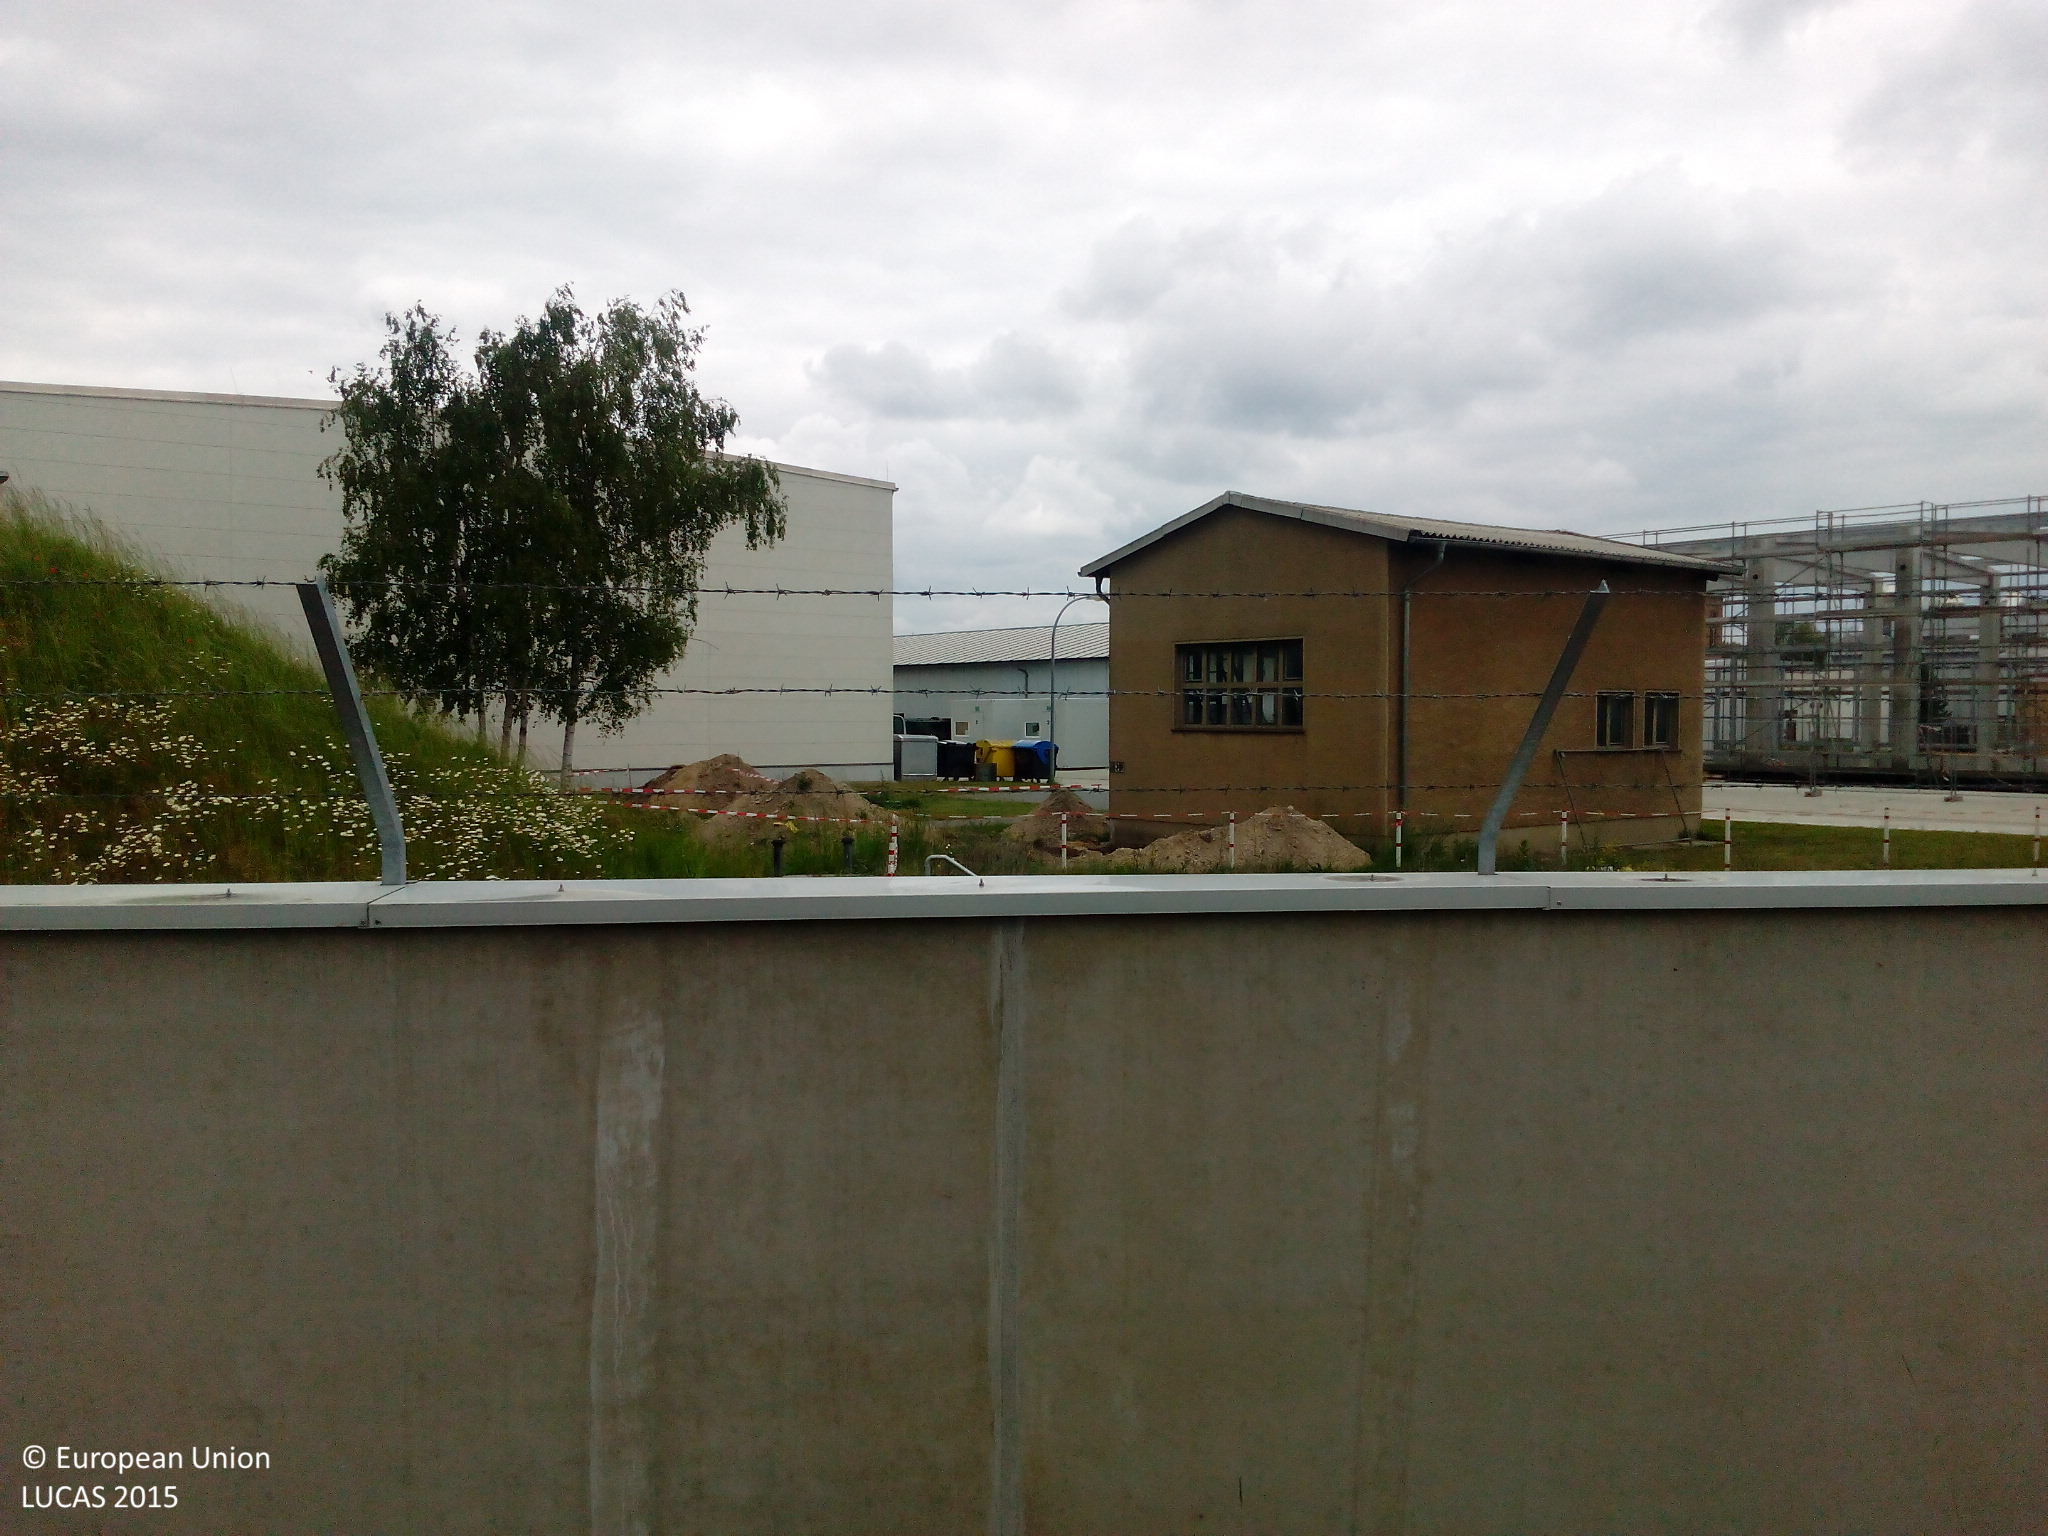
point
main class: Grassland
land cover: Grassland with sparse tree/shrub cover
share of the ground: 50 - 75 %
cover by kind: herbaceous plants 50 %, unconsolidated bare surface 45 %, broadleaved forest trees 5 %
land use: Community services
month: May
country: DE
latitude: 51.6051
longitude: 13.5379
